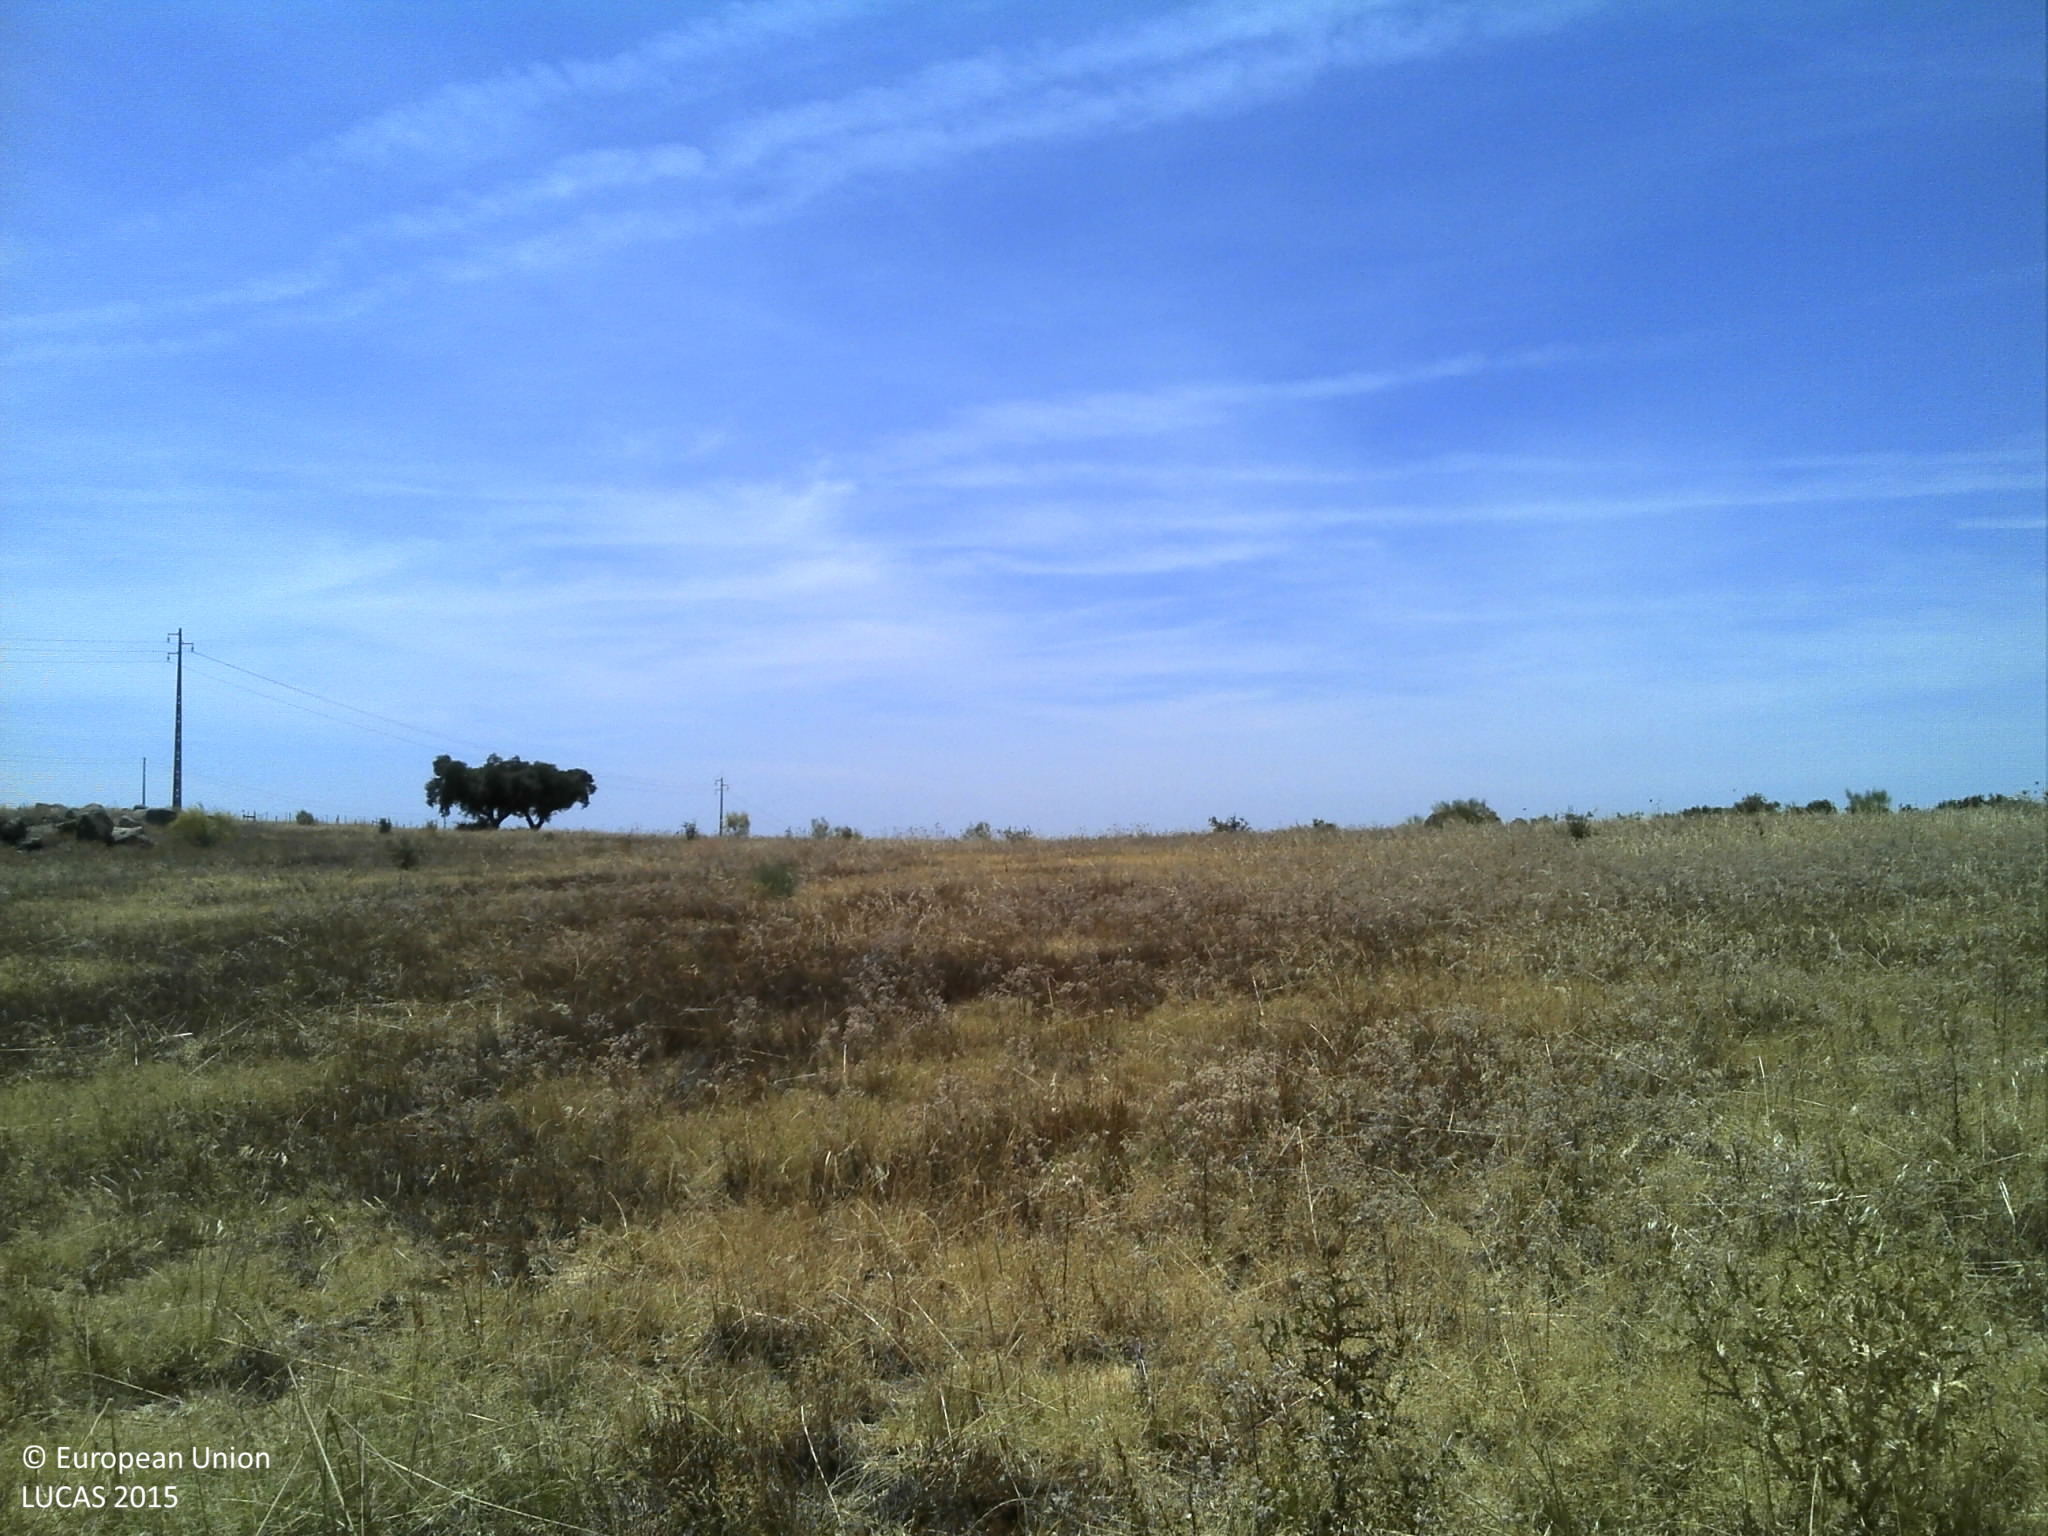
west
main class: Grassland
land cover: Grassland without tree/shrub cover
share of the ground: 25 - 50 %
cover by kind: herbaceous plants 50 %, unconsolidated bare surface 50 %
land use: Agriculture (excluding fallow land and kitchen gardens)
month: July
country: PT
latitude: 38.4178
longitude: -7.4229
